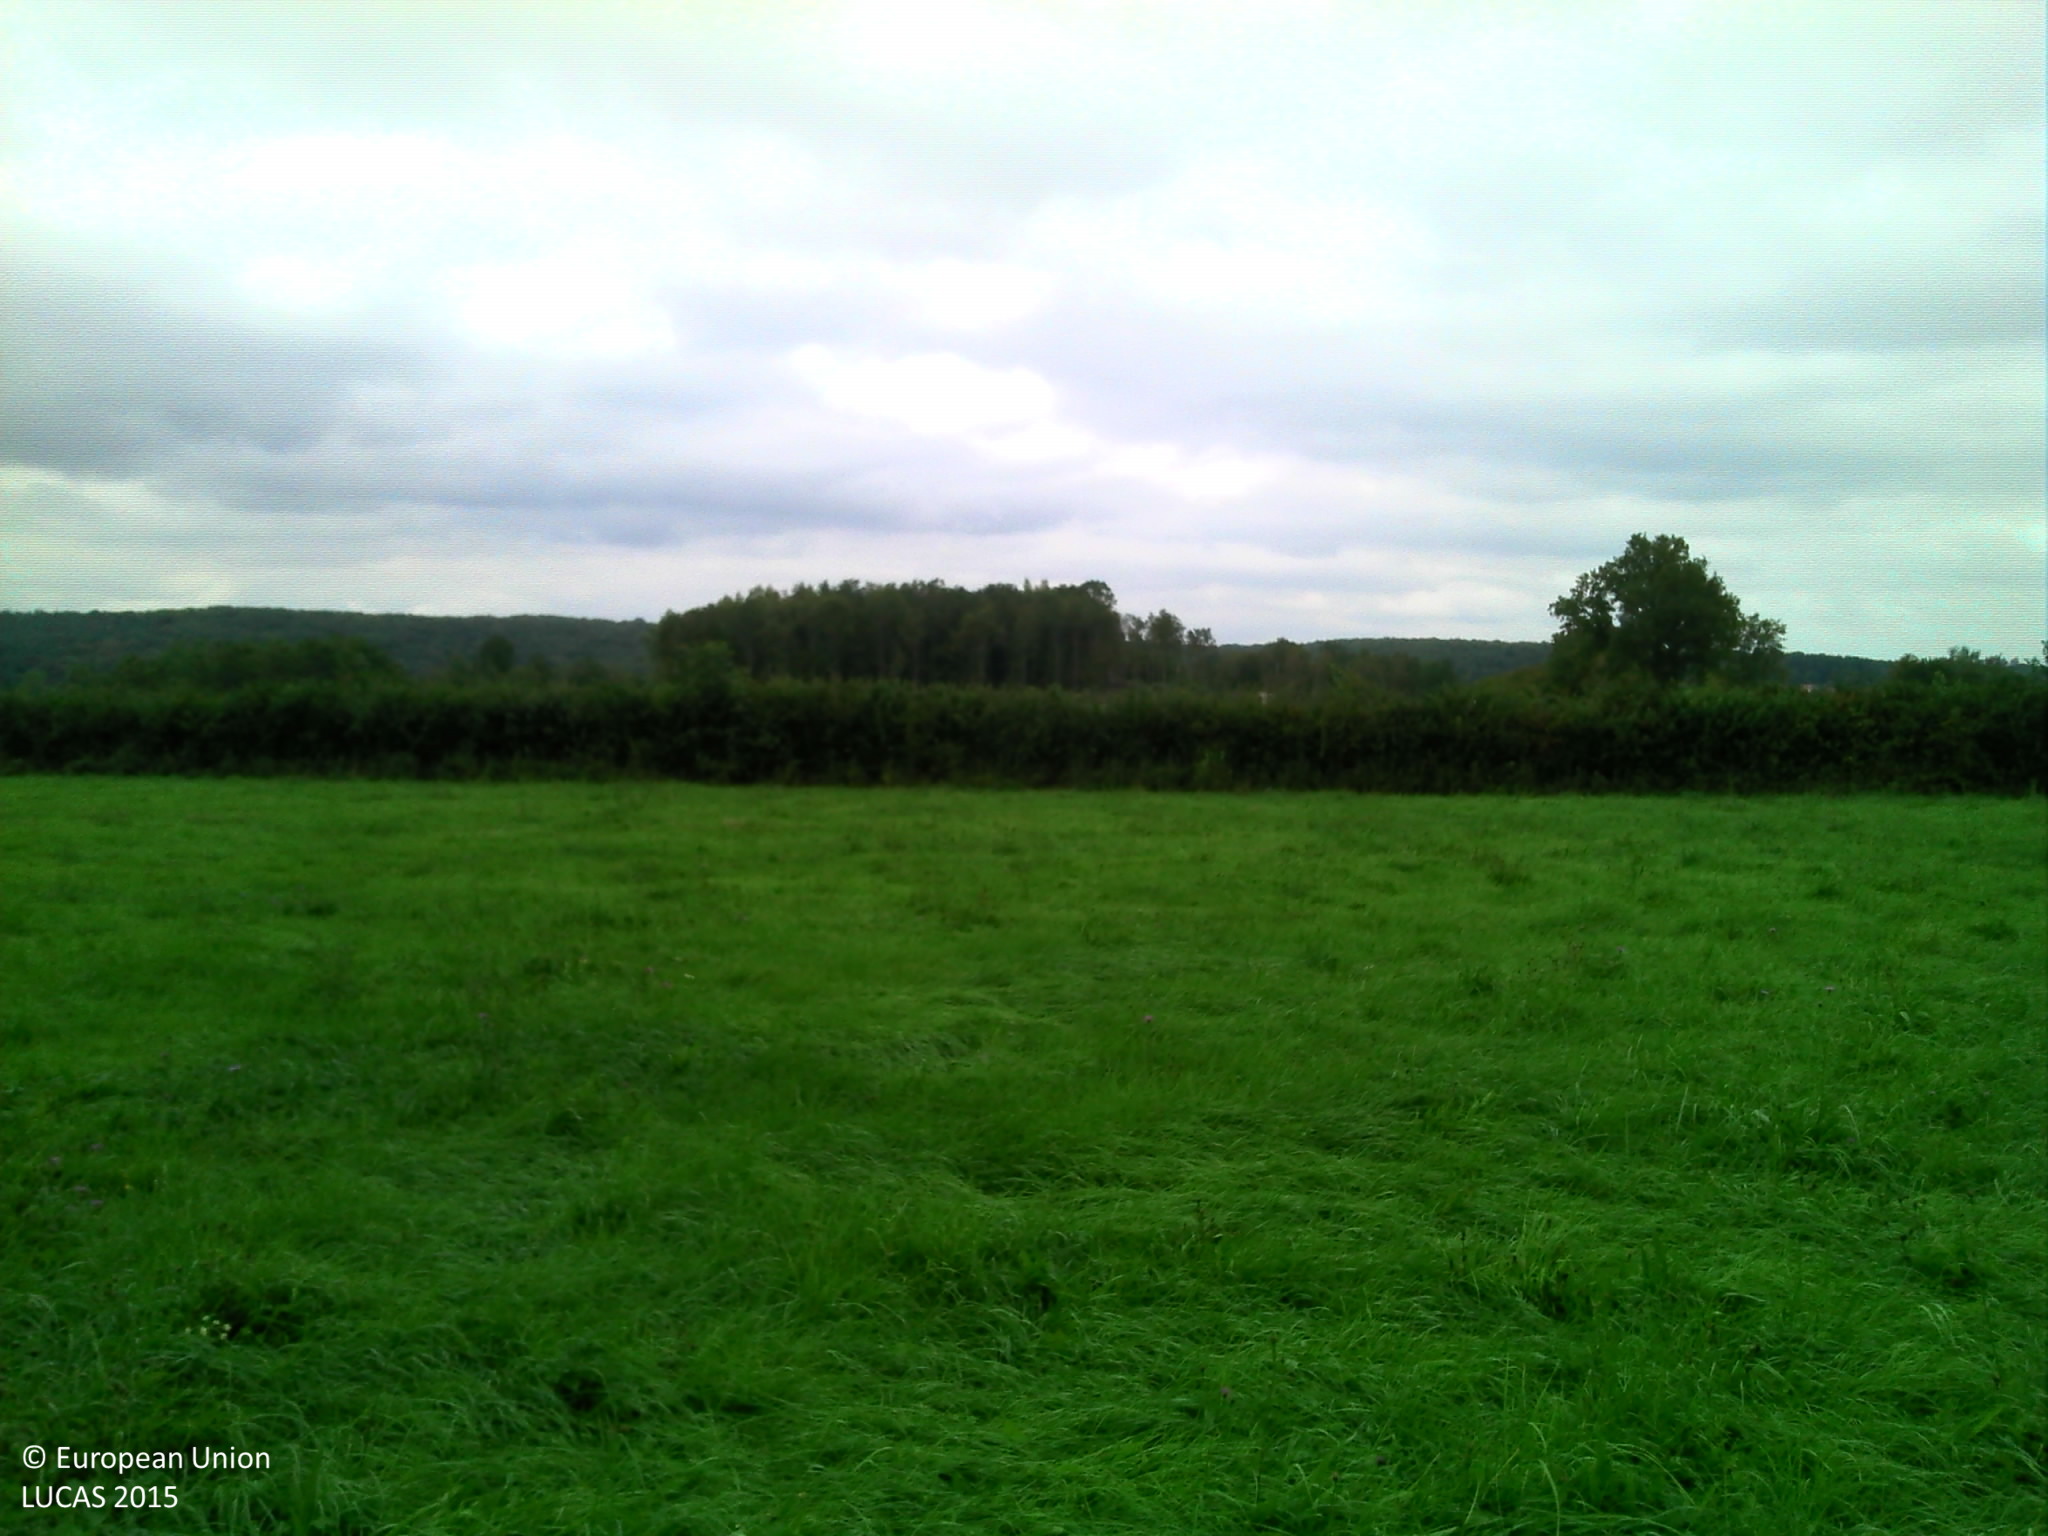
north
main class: Grassland
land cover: Grassland without tree/shrub cover
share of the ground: > 75 %
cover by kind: herbaceous plants 100 %
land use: Agriculture (excluding fallow land and kitchen gardens)
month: September
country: FR
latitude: 47.0724
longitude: 4.4294
